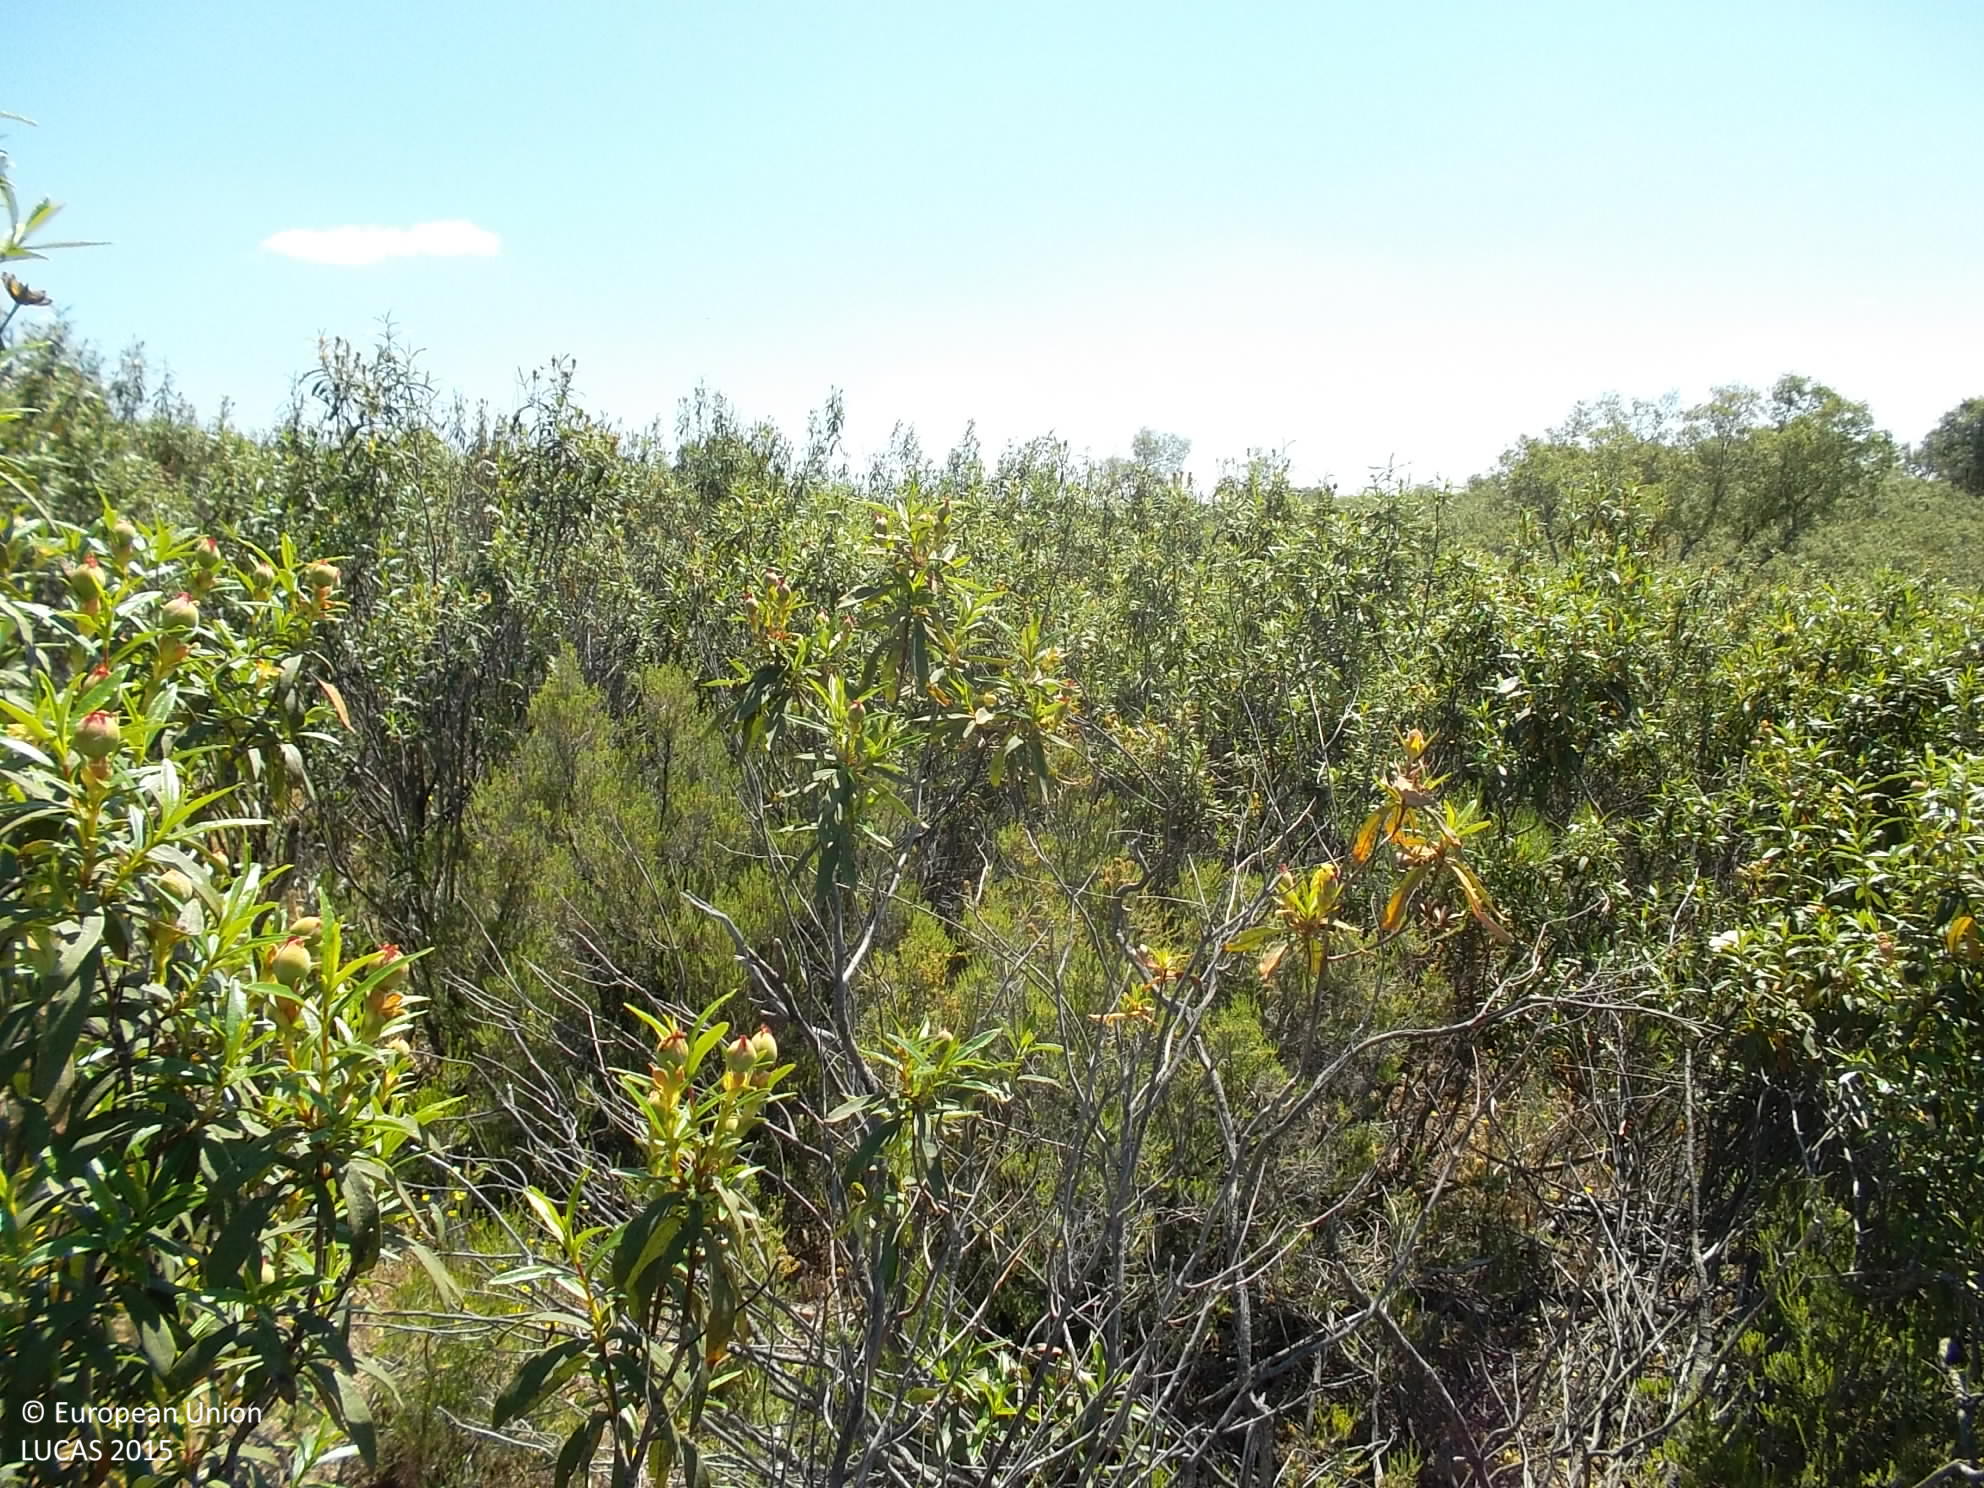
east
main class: Shrubland
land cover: Shrubland with sparse tree cover
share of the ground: > 75 %
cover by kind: shrubs 95 %, broadleaved forest trees 5 %
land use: Forestry
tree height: < 5 m
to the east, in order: Shrubland with sparse tree cover; Shrubland without tree cover; Shrubland with sparse tree cover; Grassland without tree/shrub cover; Tracks; Other structural elements; Shrubland with sparse tree cover; Shrubland without tree cover
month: May
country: ES
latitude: 38.5211
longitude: -4.3910
